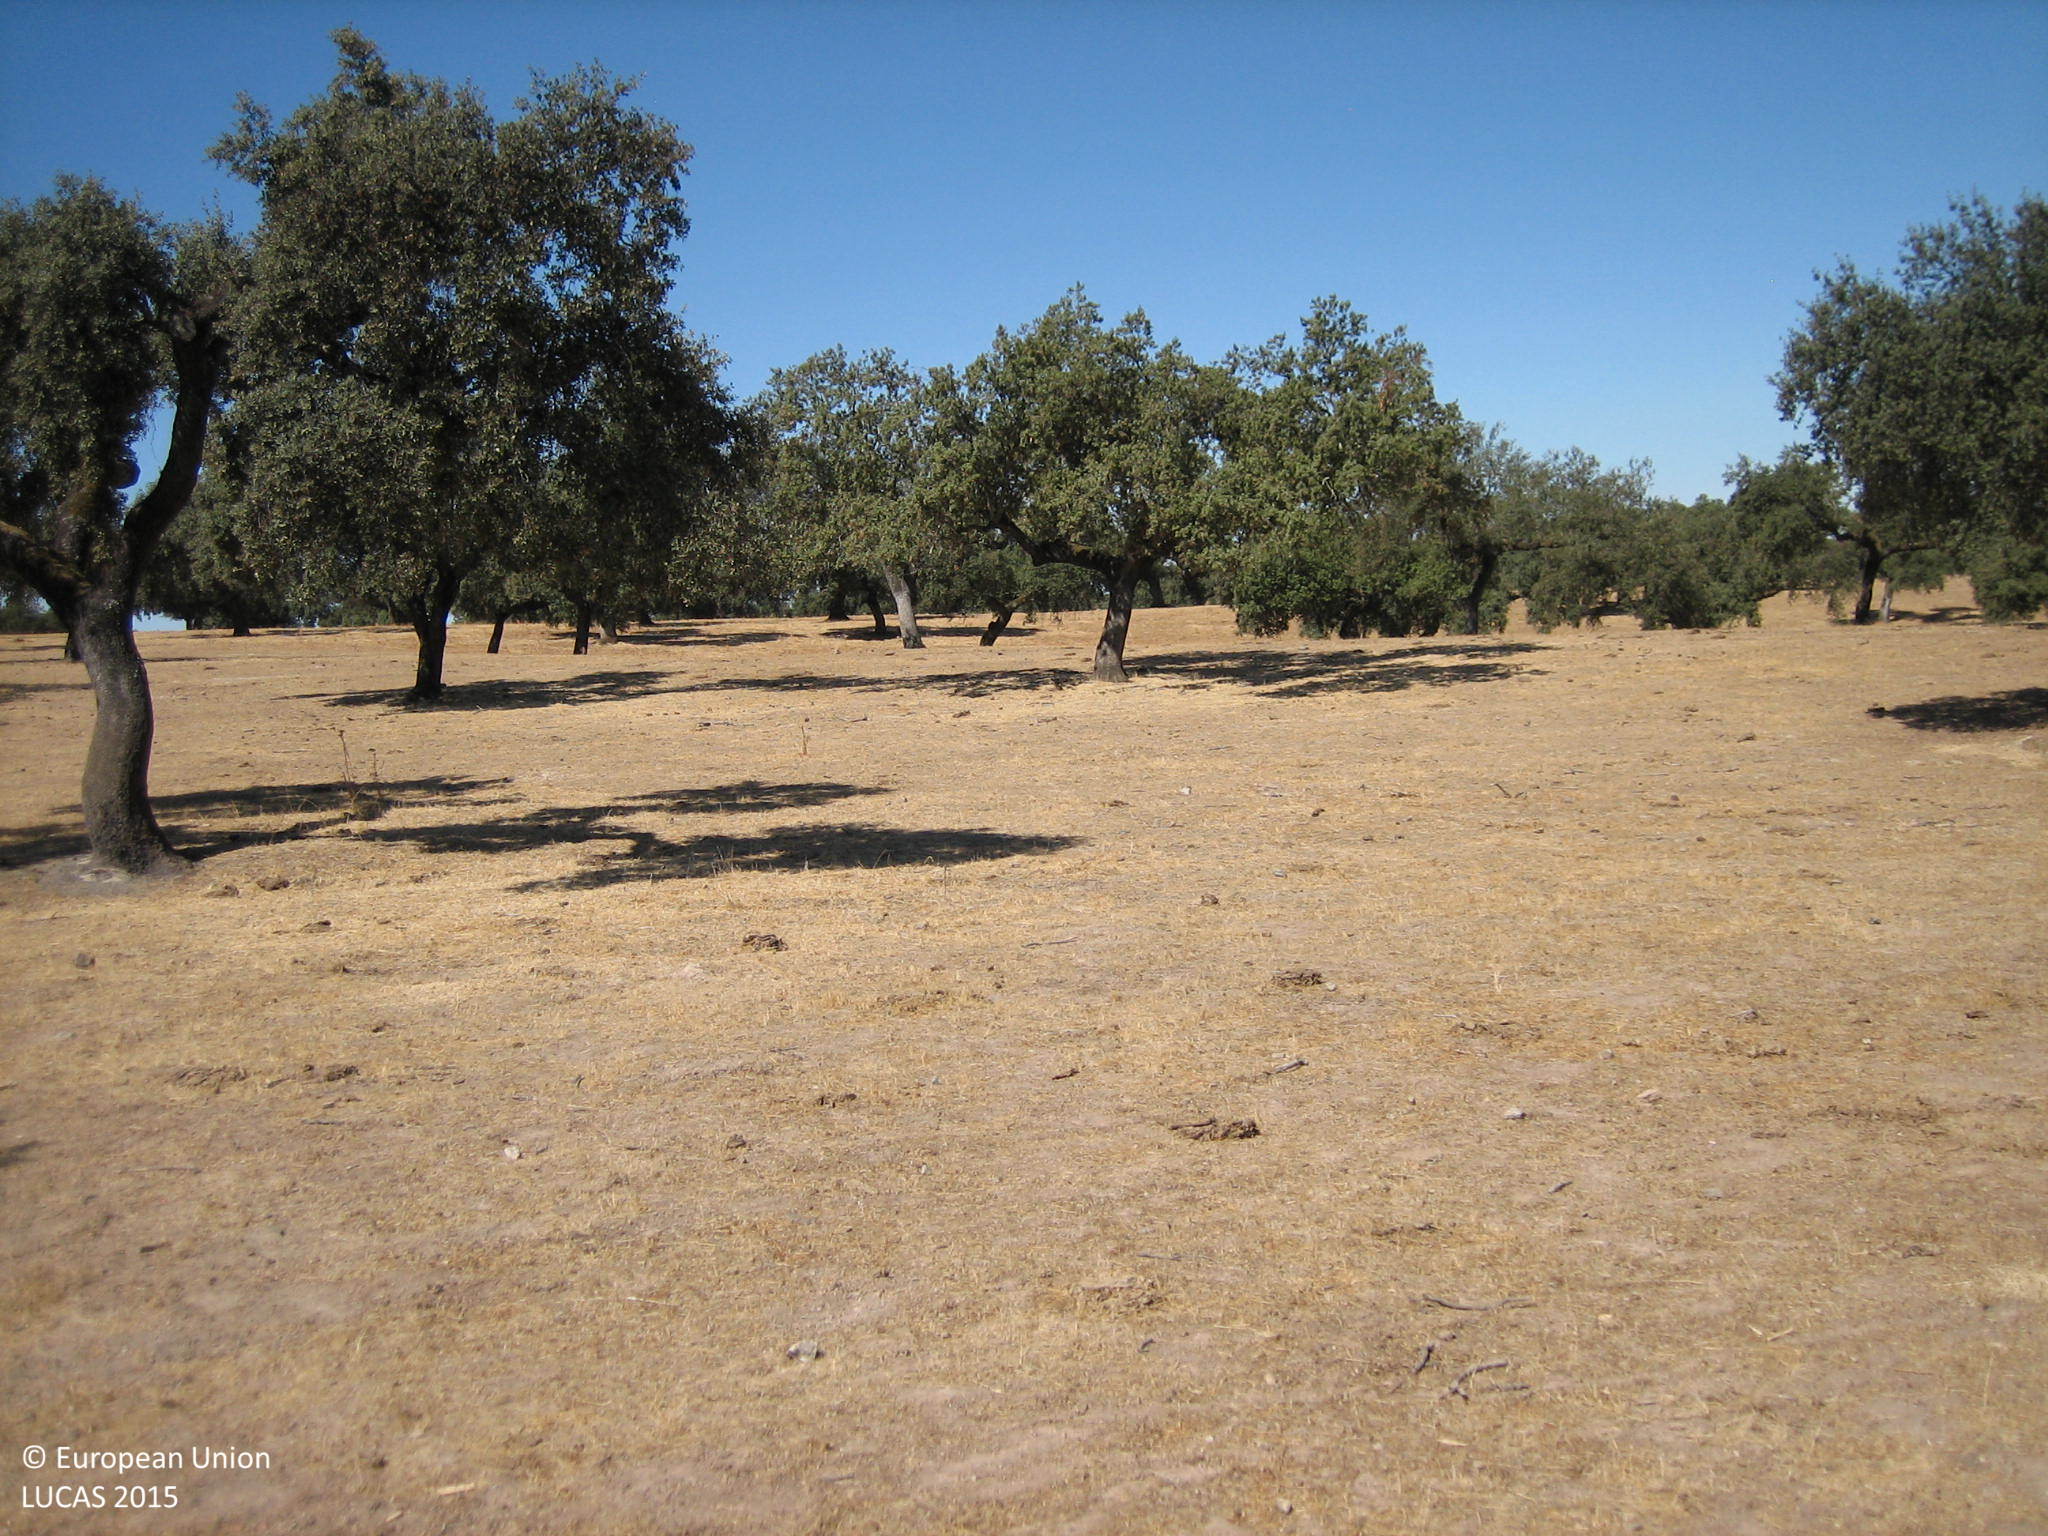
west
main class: Woodland
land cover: Broadleaved woodland
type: broadleaved evergreen forest
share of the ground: 10 - 25 %
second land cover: Grassland without tree/shrub cover
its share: 50 - 75 %
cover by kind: herbaceous plants 60 %, unconsolidated bare surface 30 %, broadleaved forest trees 10 %
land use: Forestry
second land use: Agriculture (excluding fallow land and kitchen gardens)
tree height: > 5 m
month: August
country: ES
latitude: 38.4980
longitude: -7.1862
